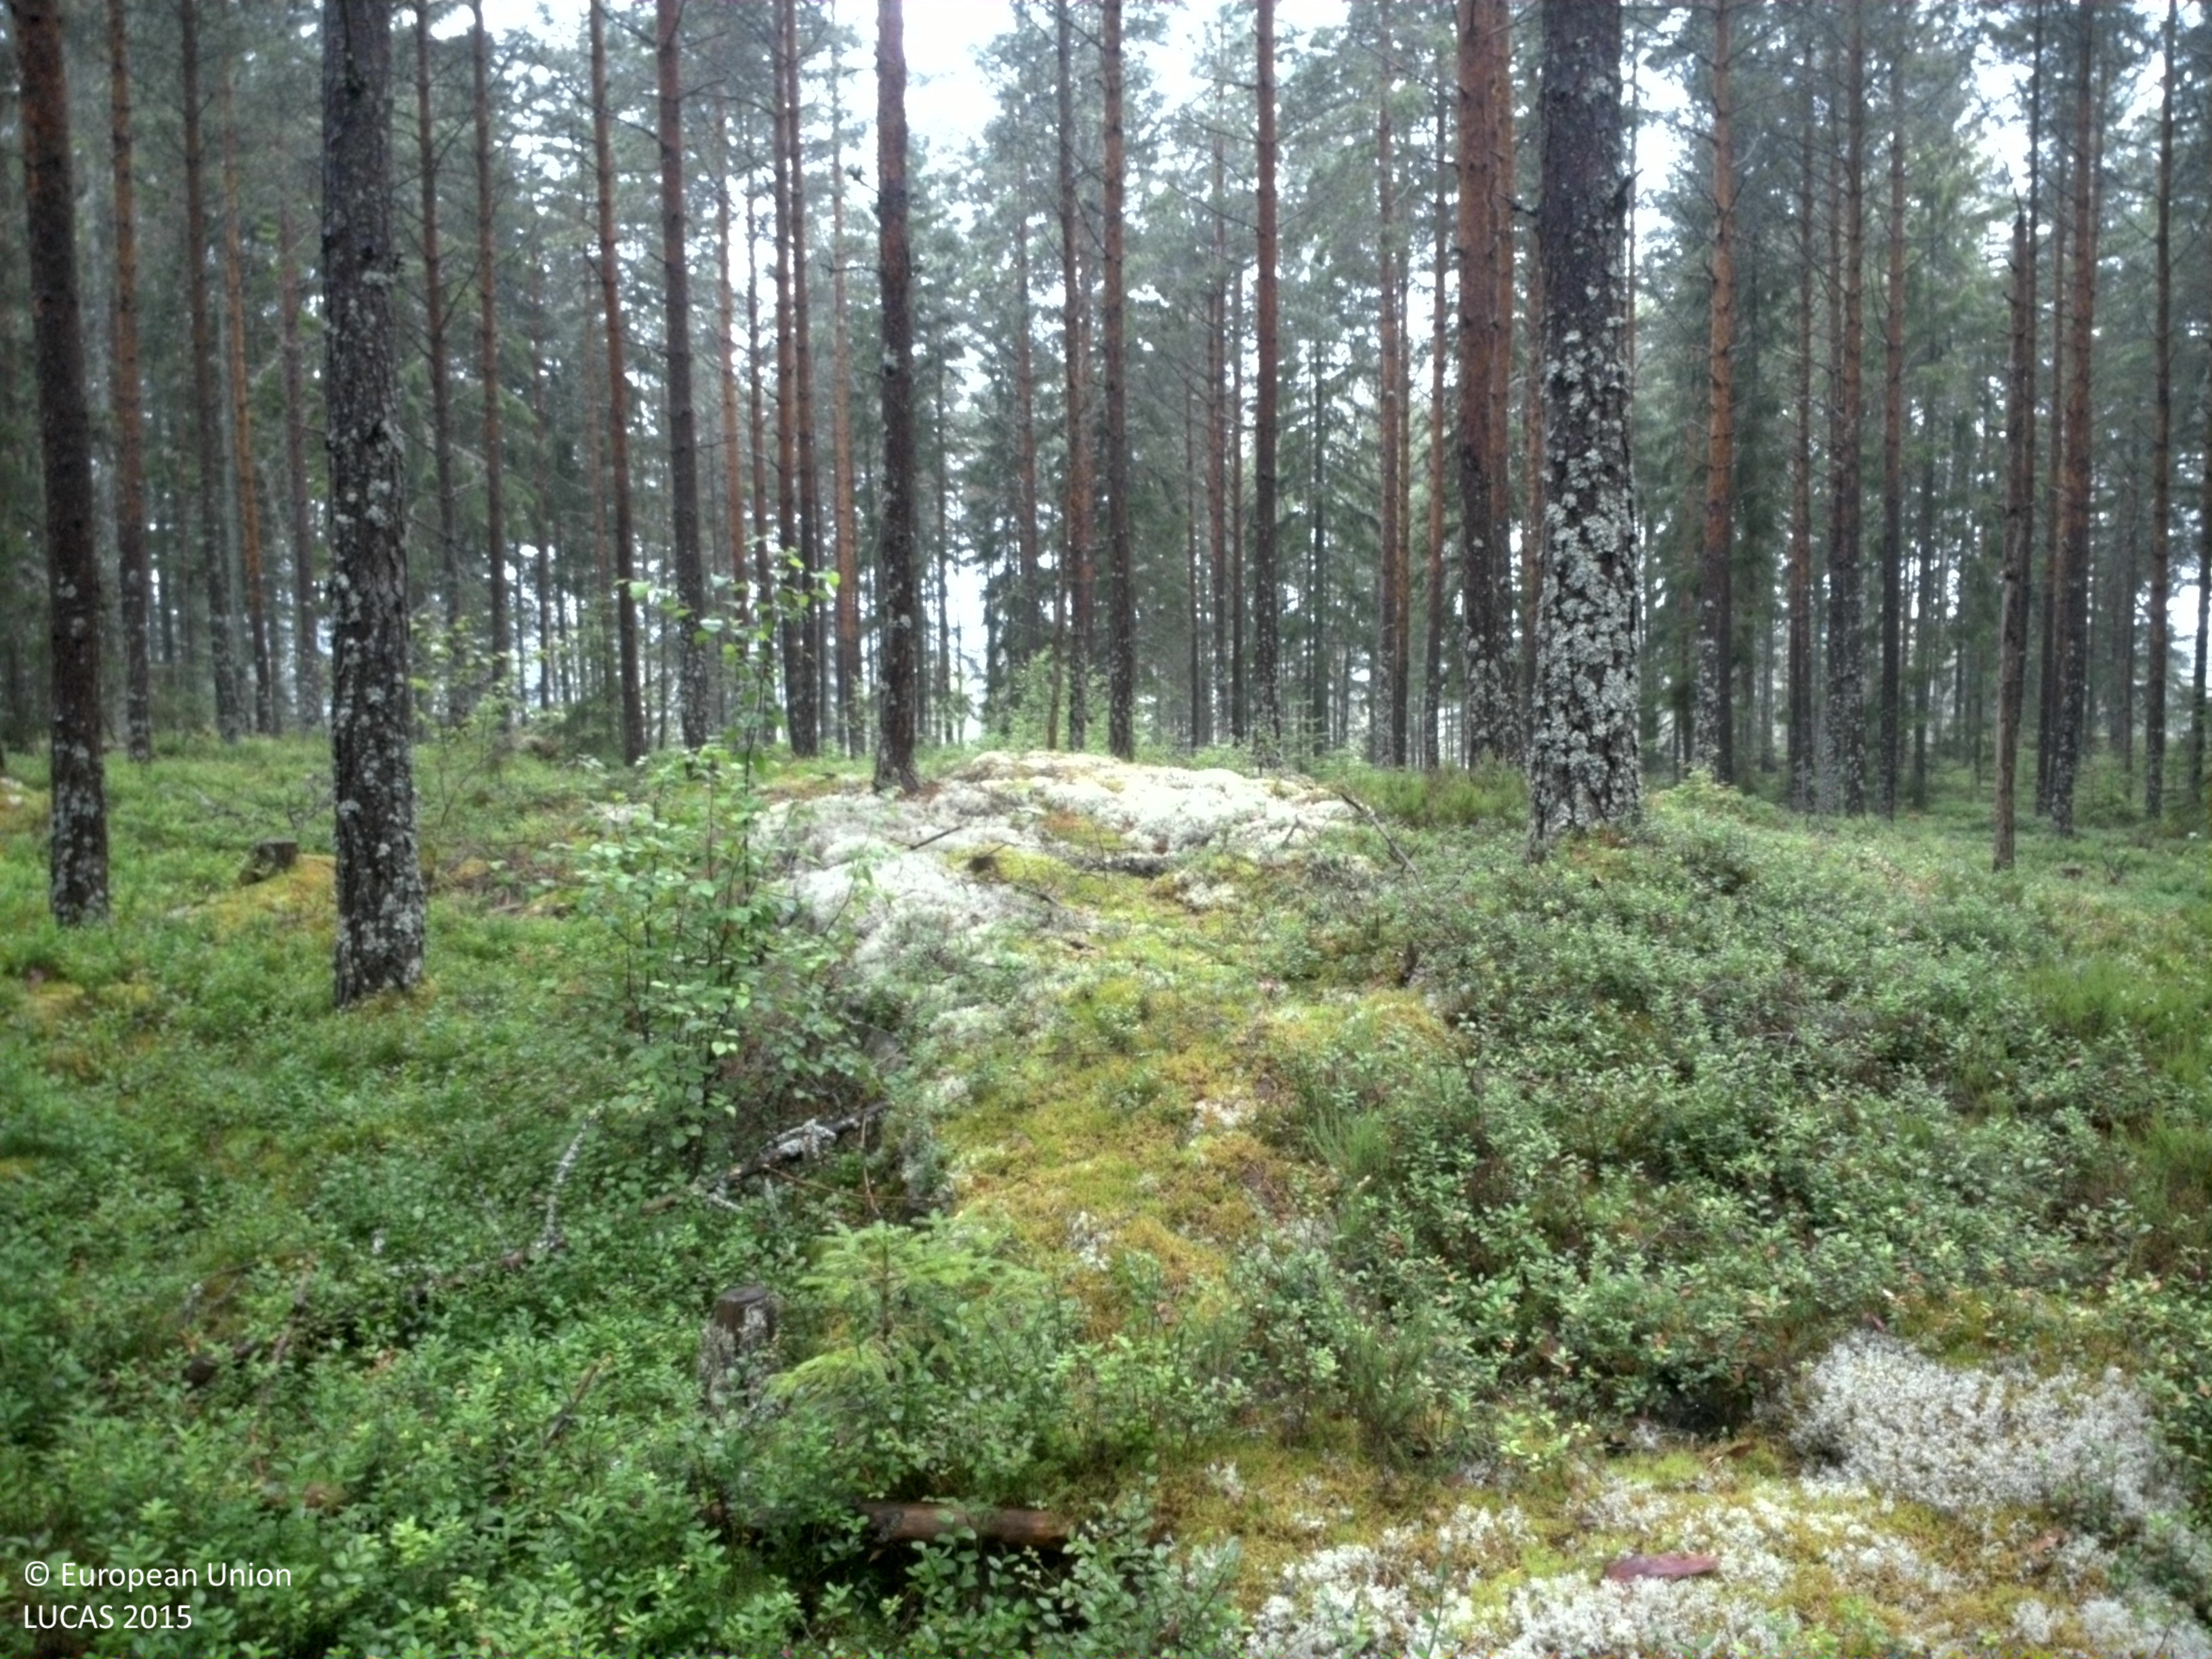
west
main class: Woodland
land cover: Pine dominated coniferous woodland
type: boreal forest
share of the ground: 50 - 75 %
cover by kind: coniferous forest trees 65 %, shrubs 20 %, lichens and mosses 10 %, broadleaved forest trees 5 %
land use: Forestry
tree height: > 5 m
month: August
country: SE
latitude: 59.4430
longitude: 13.1491
